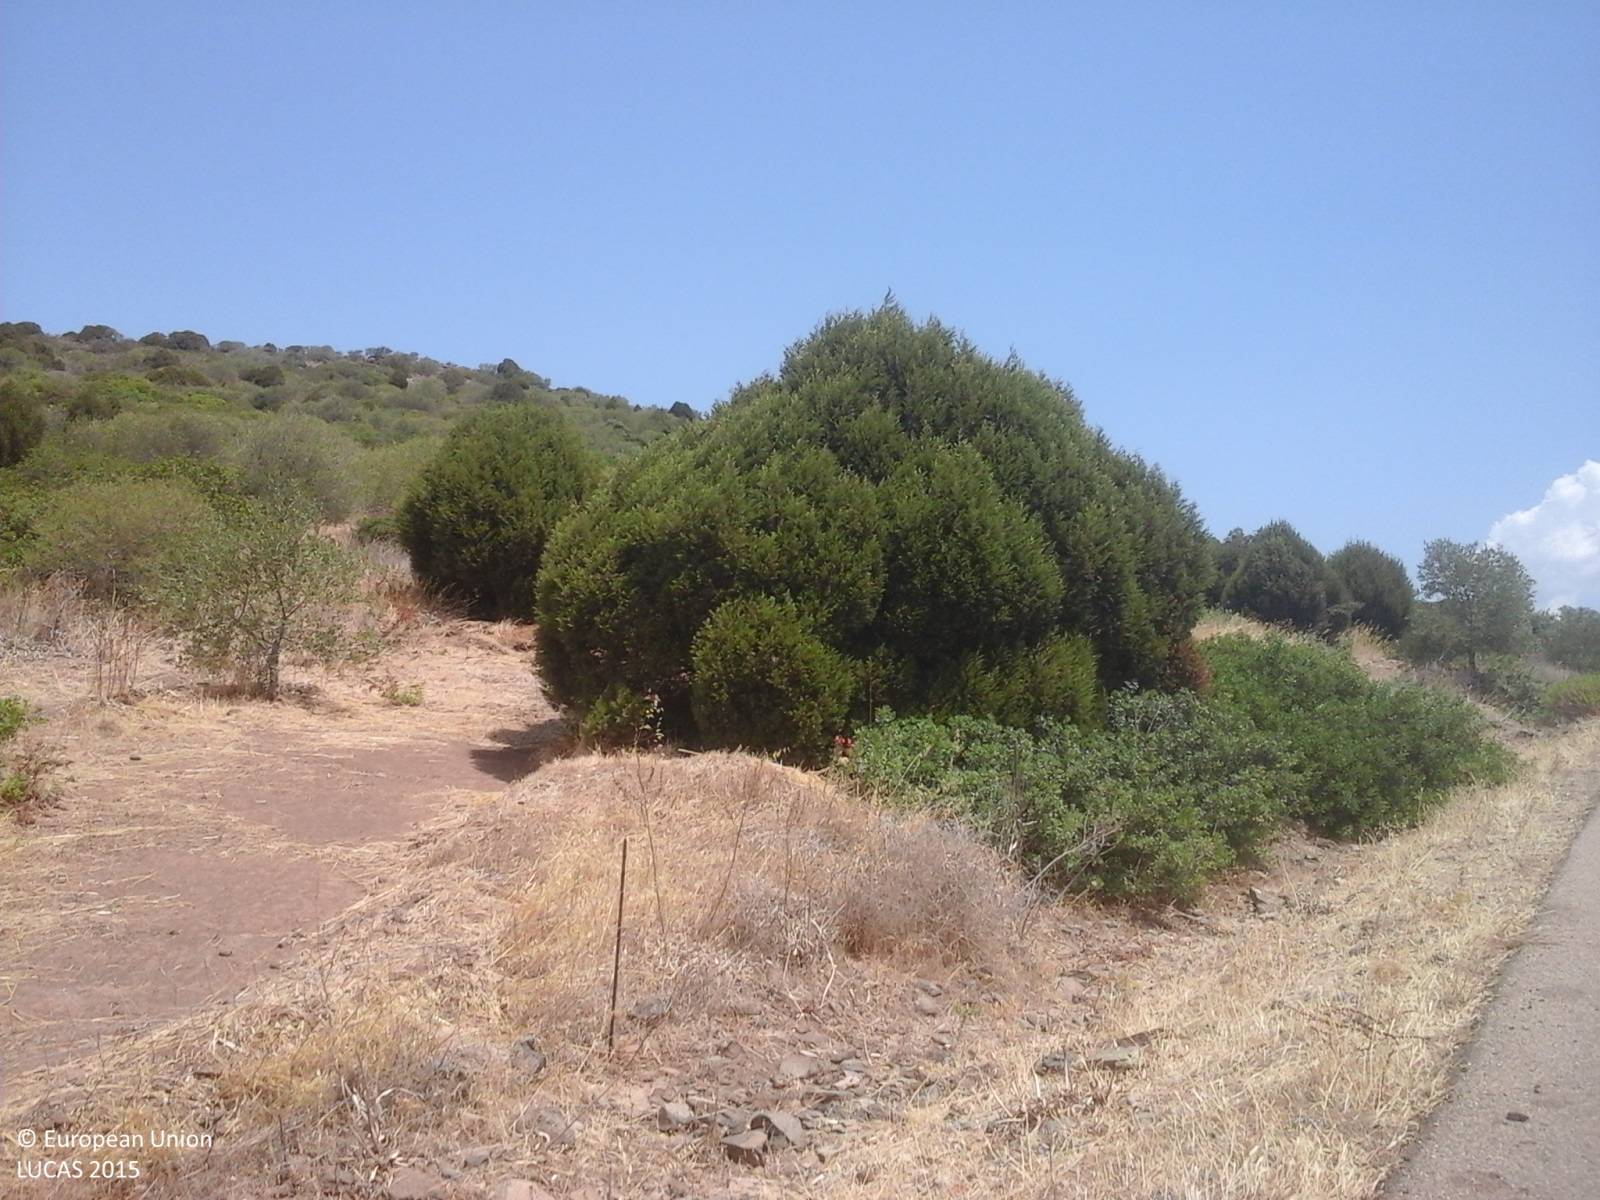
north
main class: Shrubland
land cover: Shrubland with sparse tree cover
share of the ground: > 75 %
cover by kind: shrubs 70 %, unconsolidated bare surface 20 %, broadleaved forest trees 5 %, herbaceous plants 5 %
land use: Agriculture (excluding fallow land and kitchen gardens)
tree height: < 5 m
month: July
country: IT
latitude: 39.1165
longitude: 8.6323
